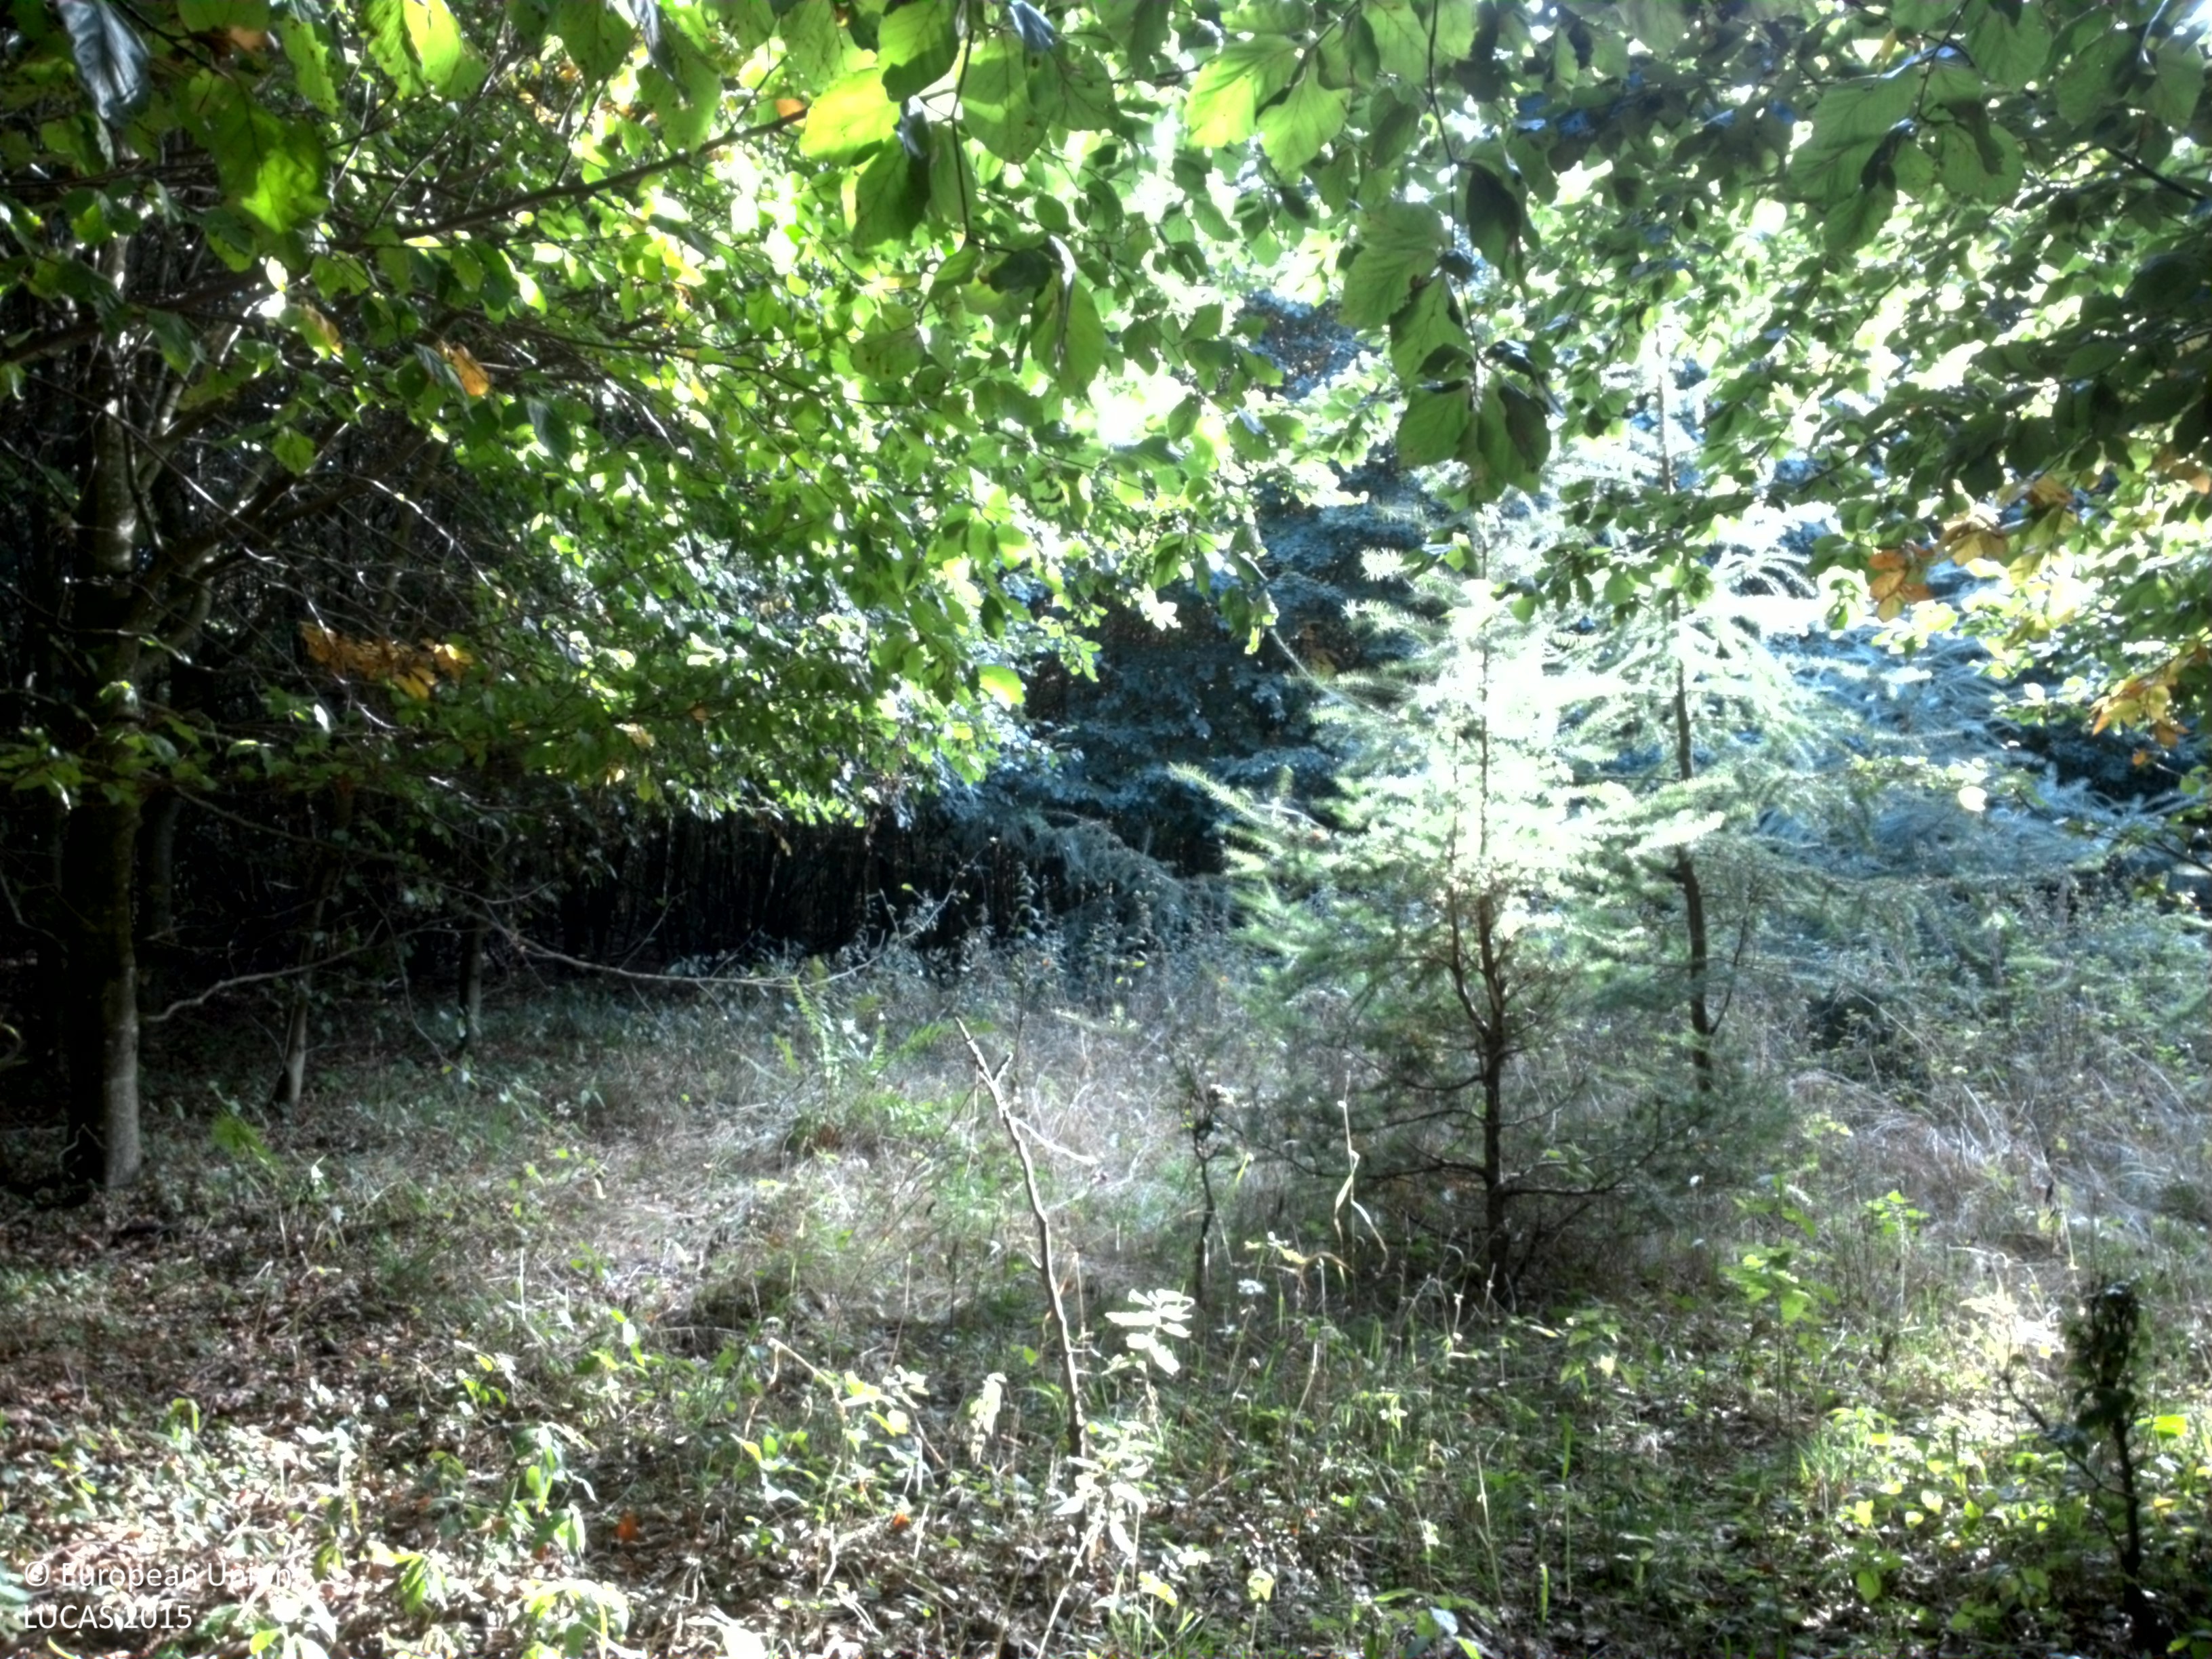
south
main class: Woodland
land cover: Broadleaved woodland
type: beech forest
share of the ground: > 75 %
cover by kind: broadleaved forest trees 90 %, herbaceous plants 5 %, unconsolidated bare surface 5 %
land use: Forestry
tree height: < 5 m
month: October
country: SE
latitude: 55.6854
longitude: 13.6723
